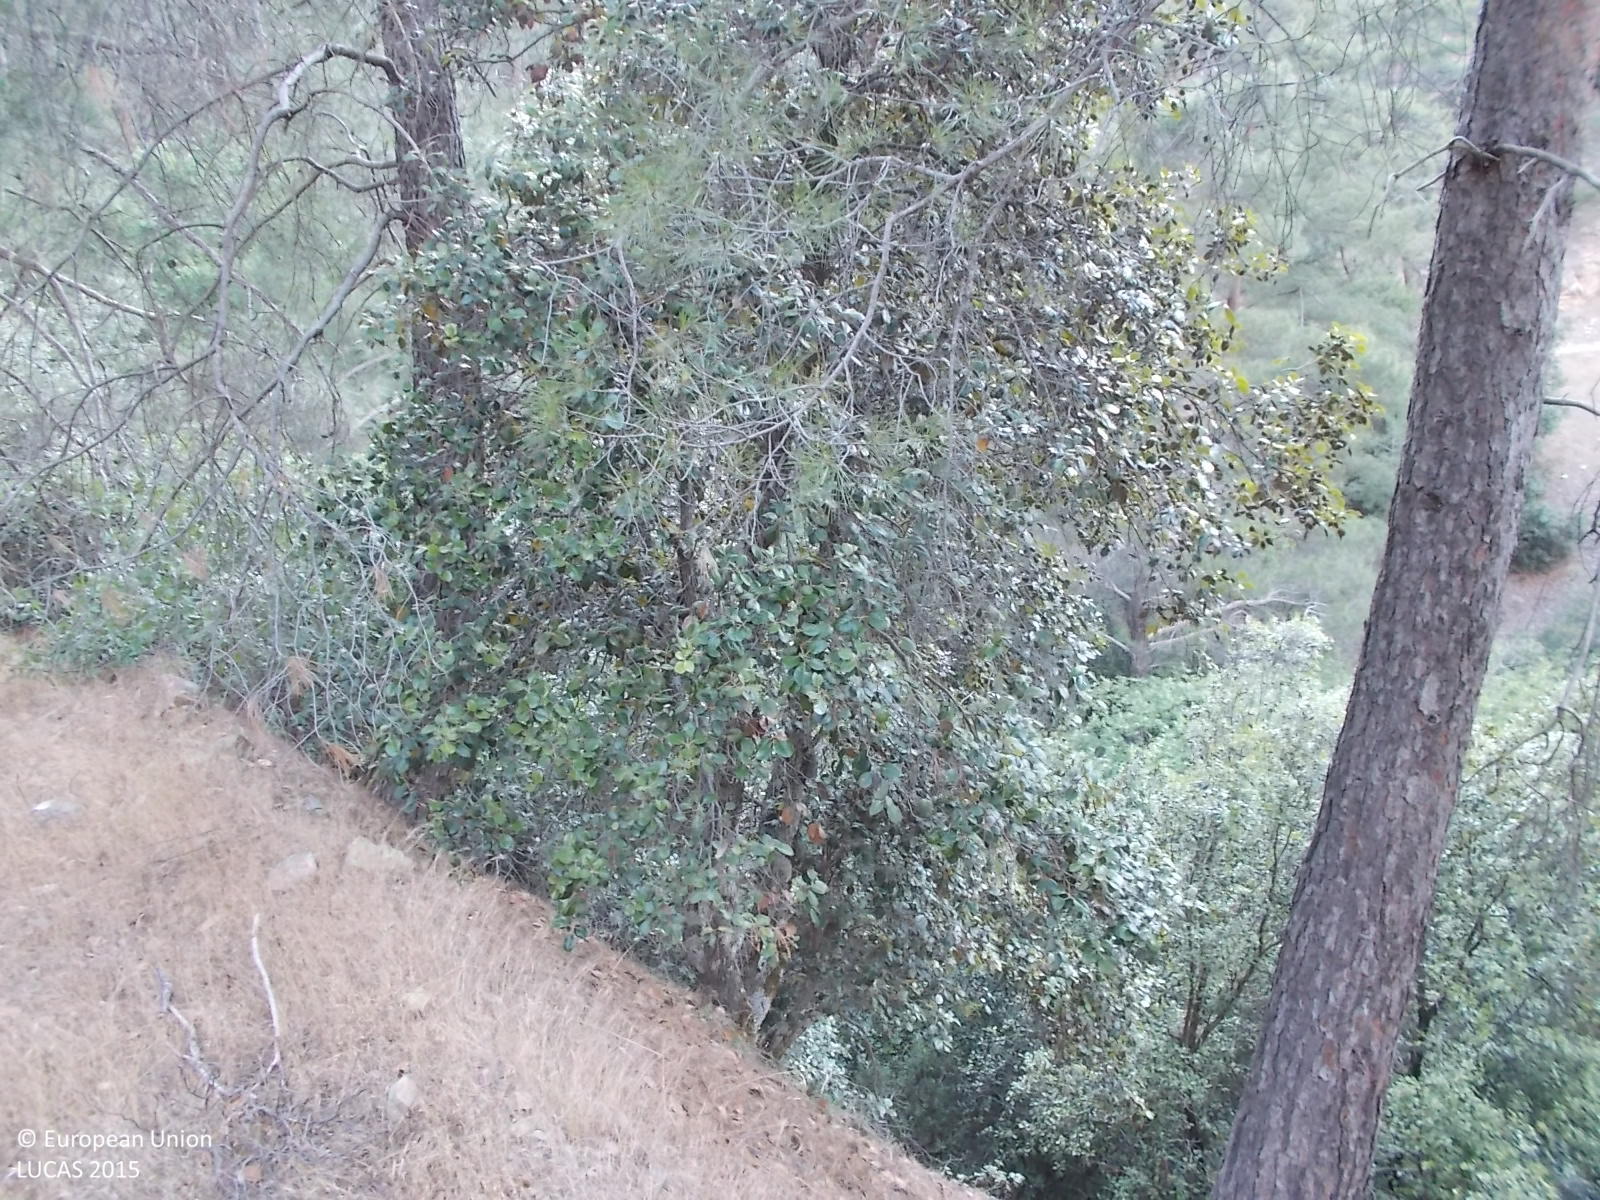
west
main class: Woodland
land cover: Pine dominated mixed woodland
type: coniferous forest of the mediterranean region
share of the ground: > 75 %
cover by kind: coniferous forest trees 60 %, broadleaved forest trees 25 %, shrubs 10 %, unconsolidated bare surface 5 %
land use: Forestry
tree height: > 5 m
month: June
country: CY
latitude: 35.0570
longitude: 32.6275
